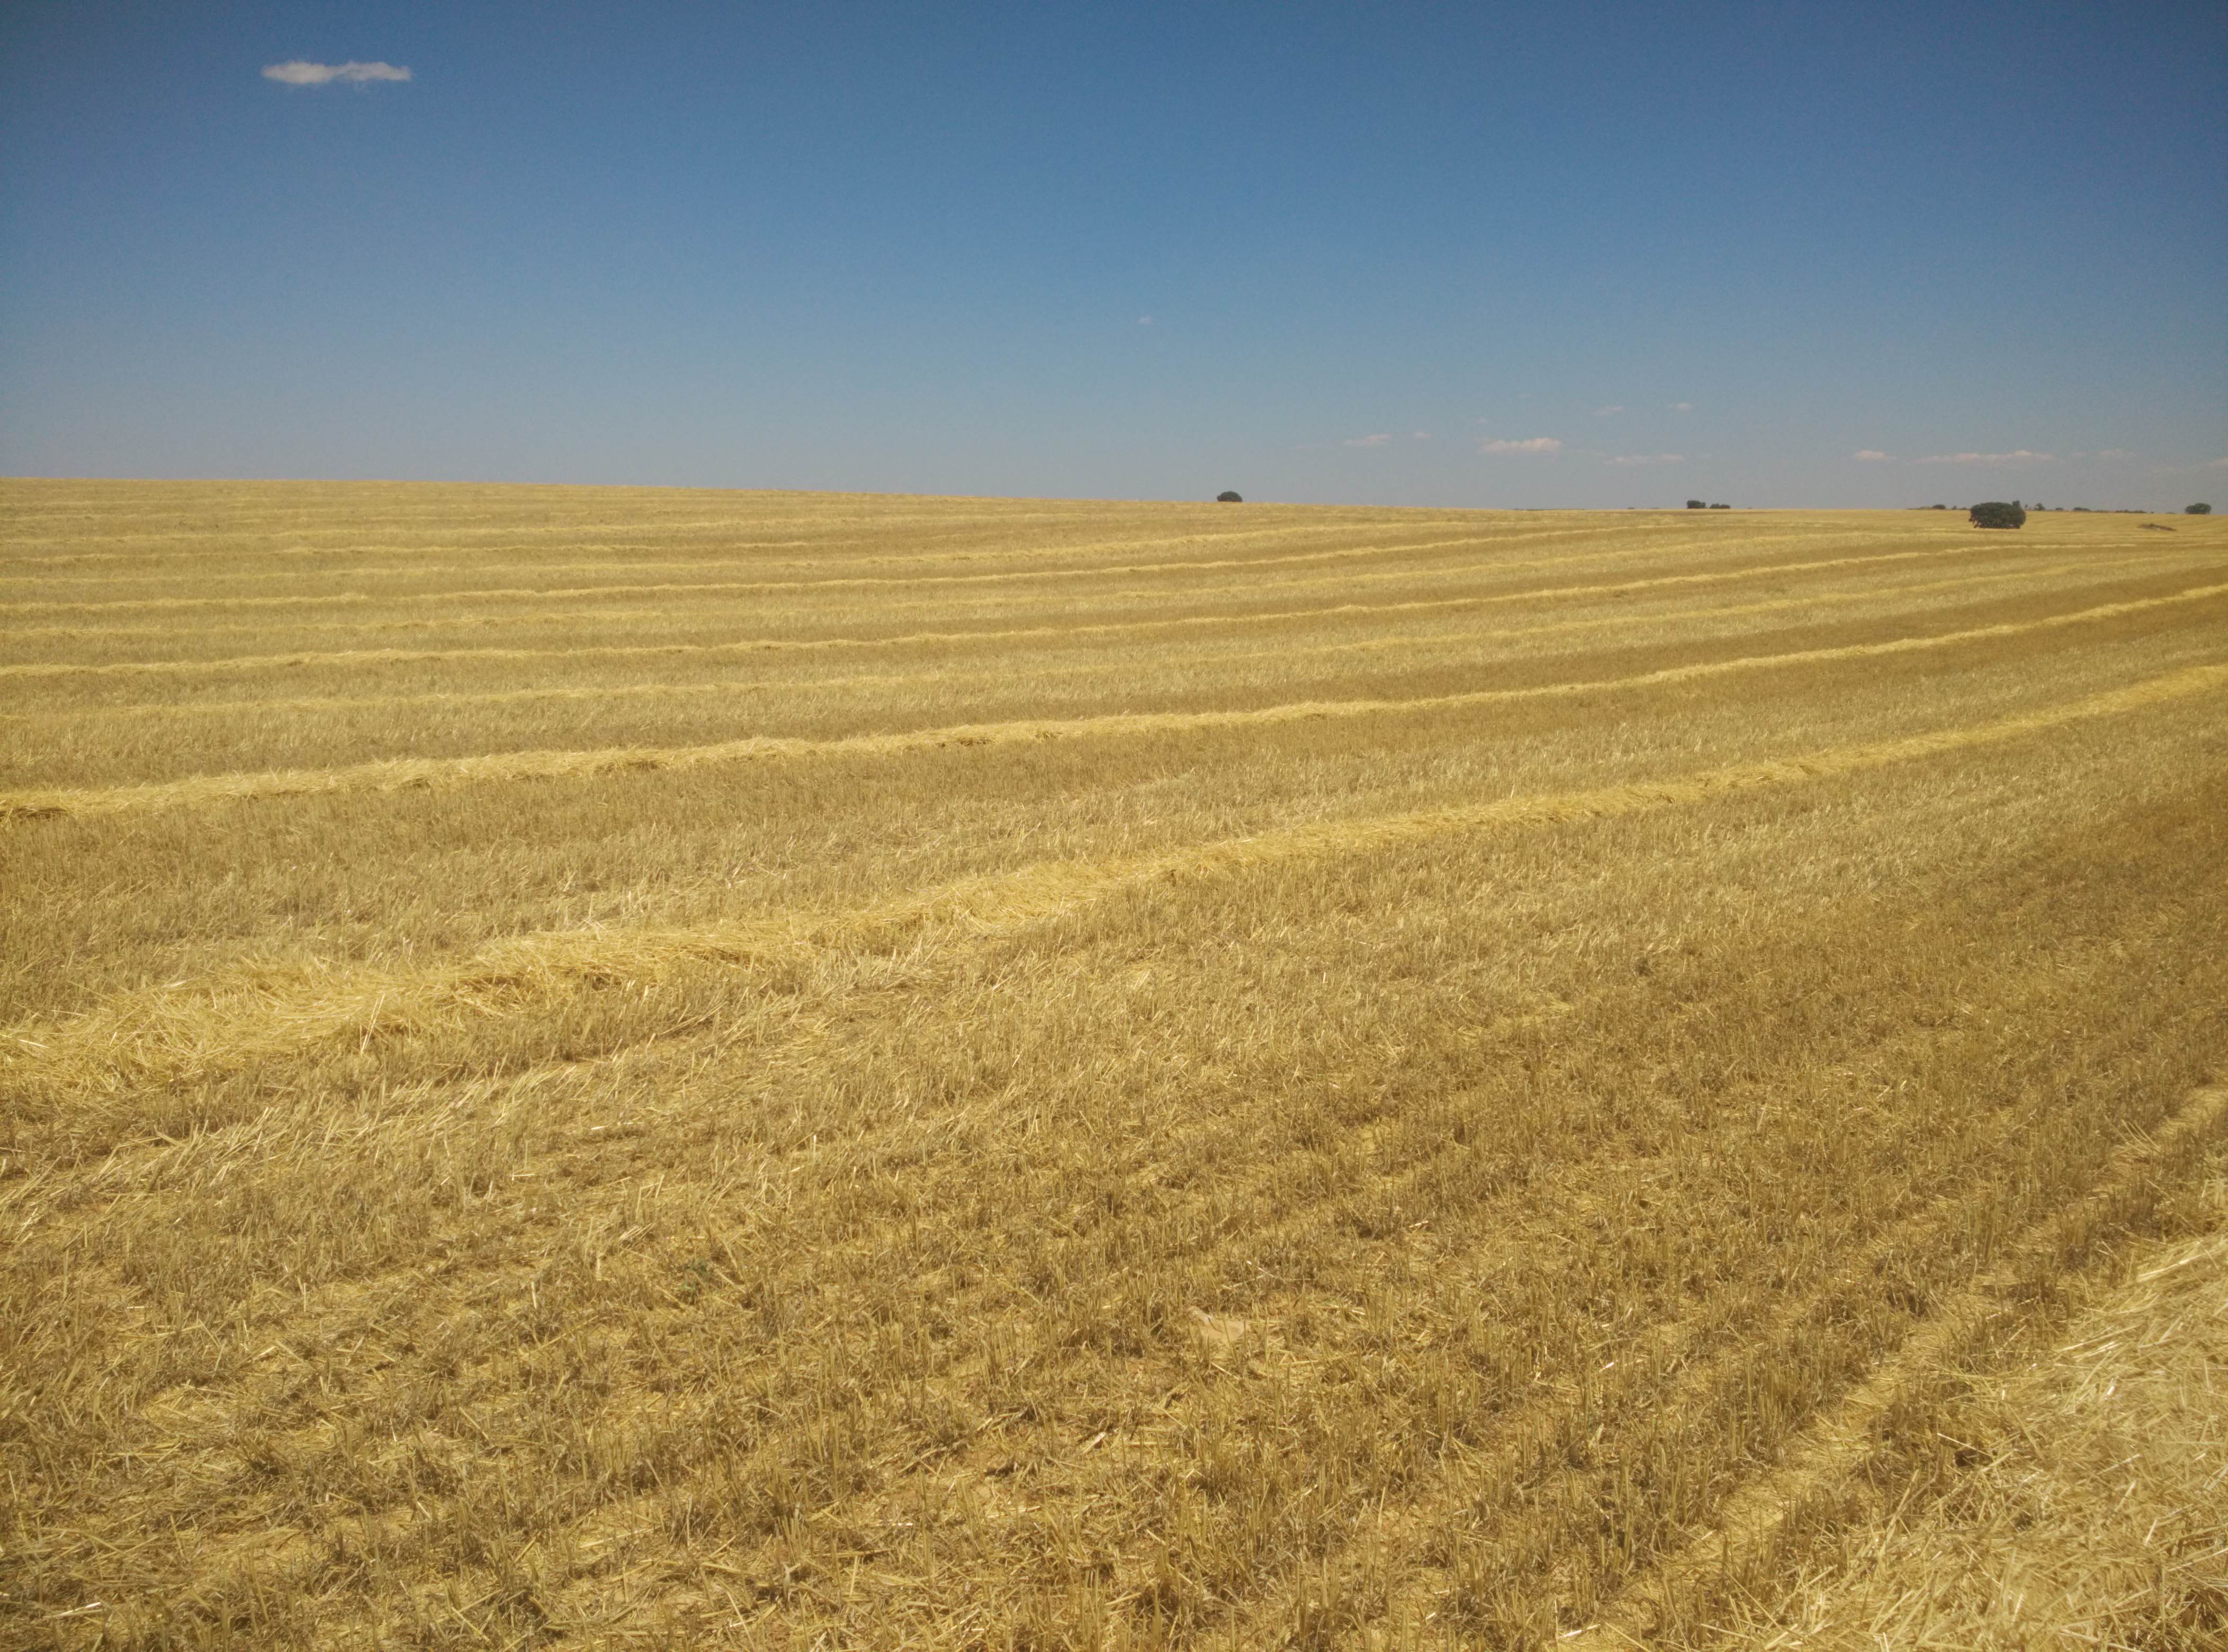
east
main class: Cropland
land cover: Common wheat
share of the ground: < 10 %
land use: Agriculture (excluding fallow land and kitchen gardens)
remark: Harvested field
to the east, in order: Common wheat
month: July
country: ES
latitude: 40.8807
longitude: -2.7170
